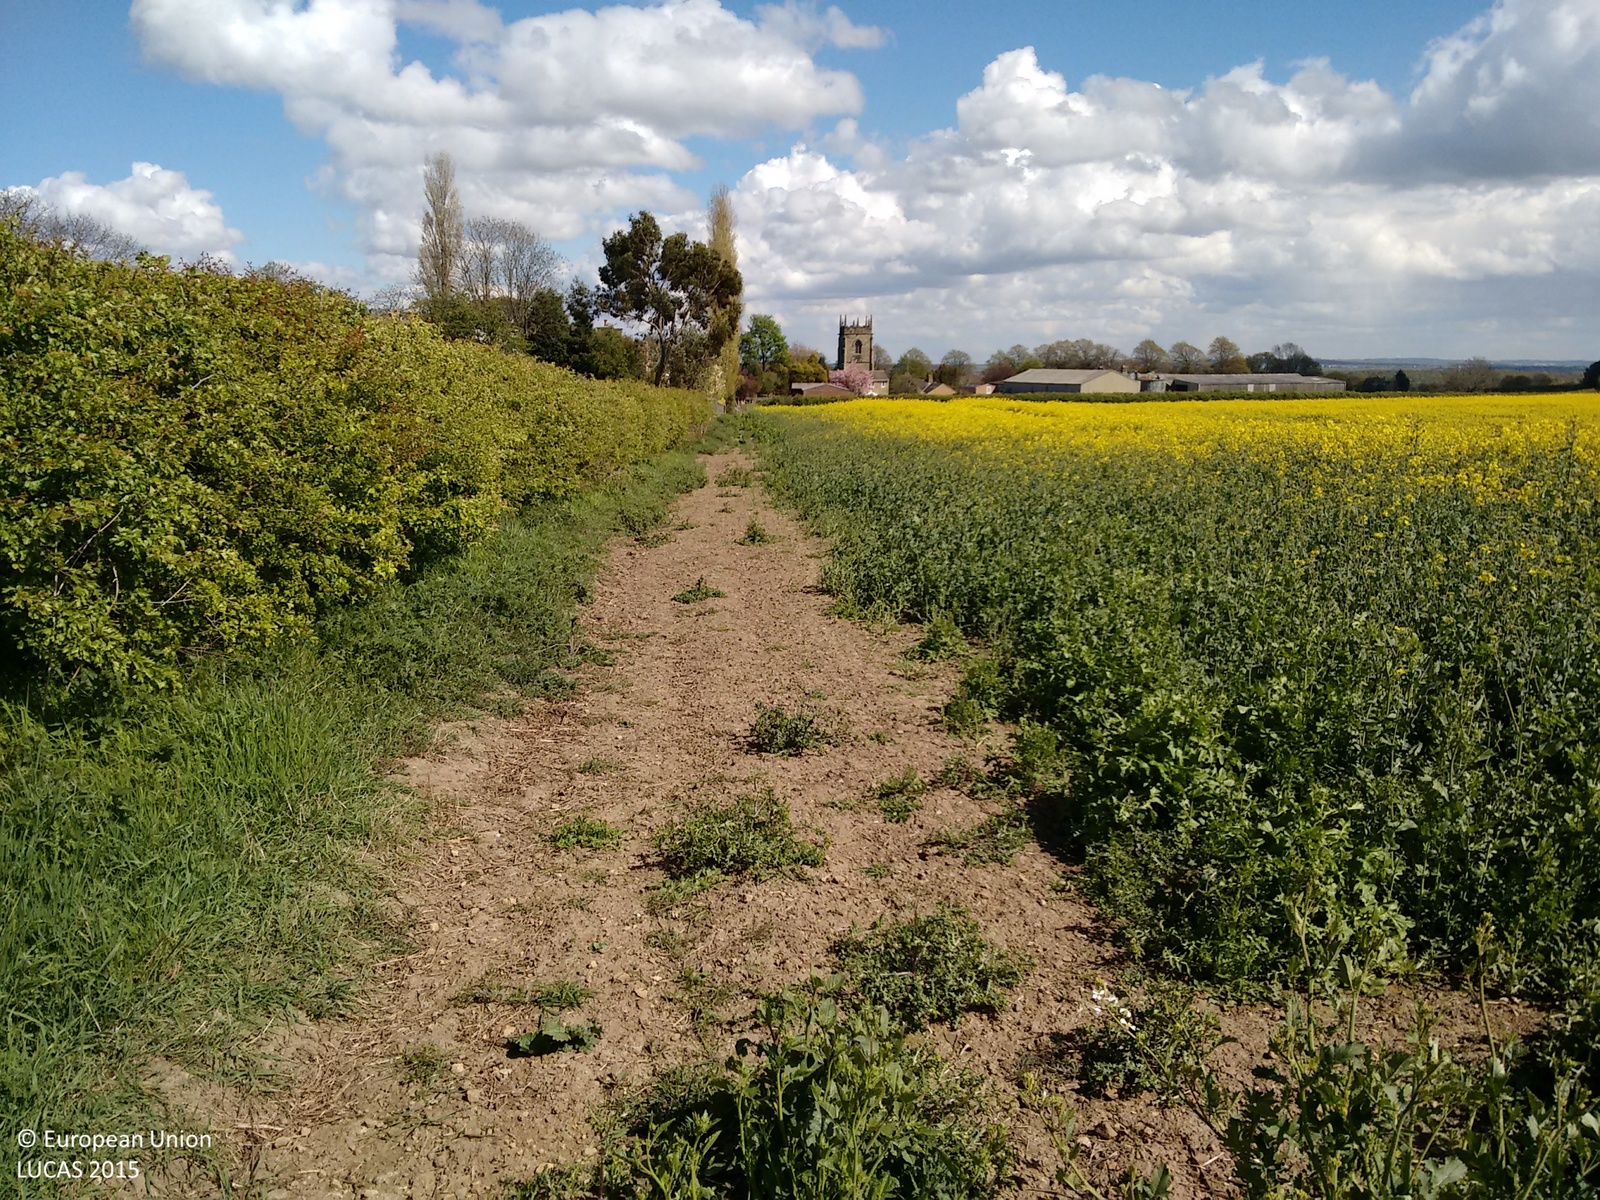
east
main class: Grassland
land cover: Grassland without tree/shrub cover
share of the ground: 50 - 75 %
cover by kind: herbaceous plants 60 %, unconsolidated bare surface 40 %
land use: Agriculture (excluding fallow land and kitchen gardens)
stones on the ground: 10 - 25 %
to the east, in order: Grassland without tree/shrub cover; Managed hedges; Grassland without tree/shrub cover; Artificial constructions in urban areas
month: April
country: GB
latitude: 53.6129
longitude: -1.5230
